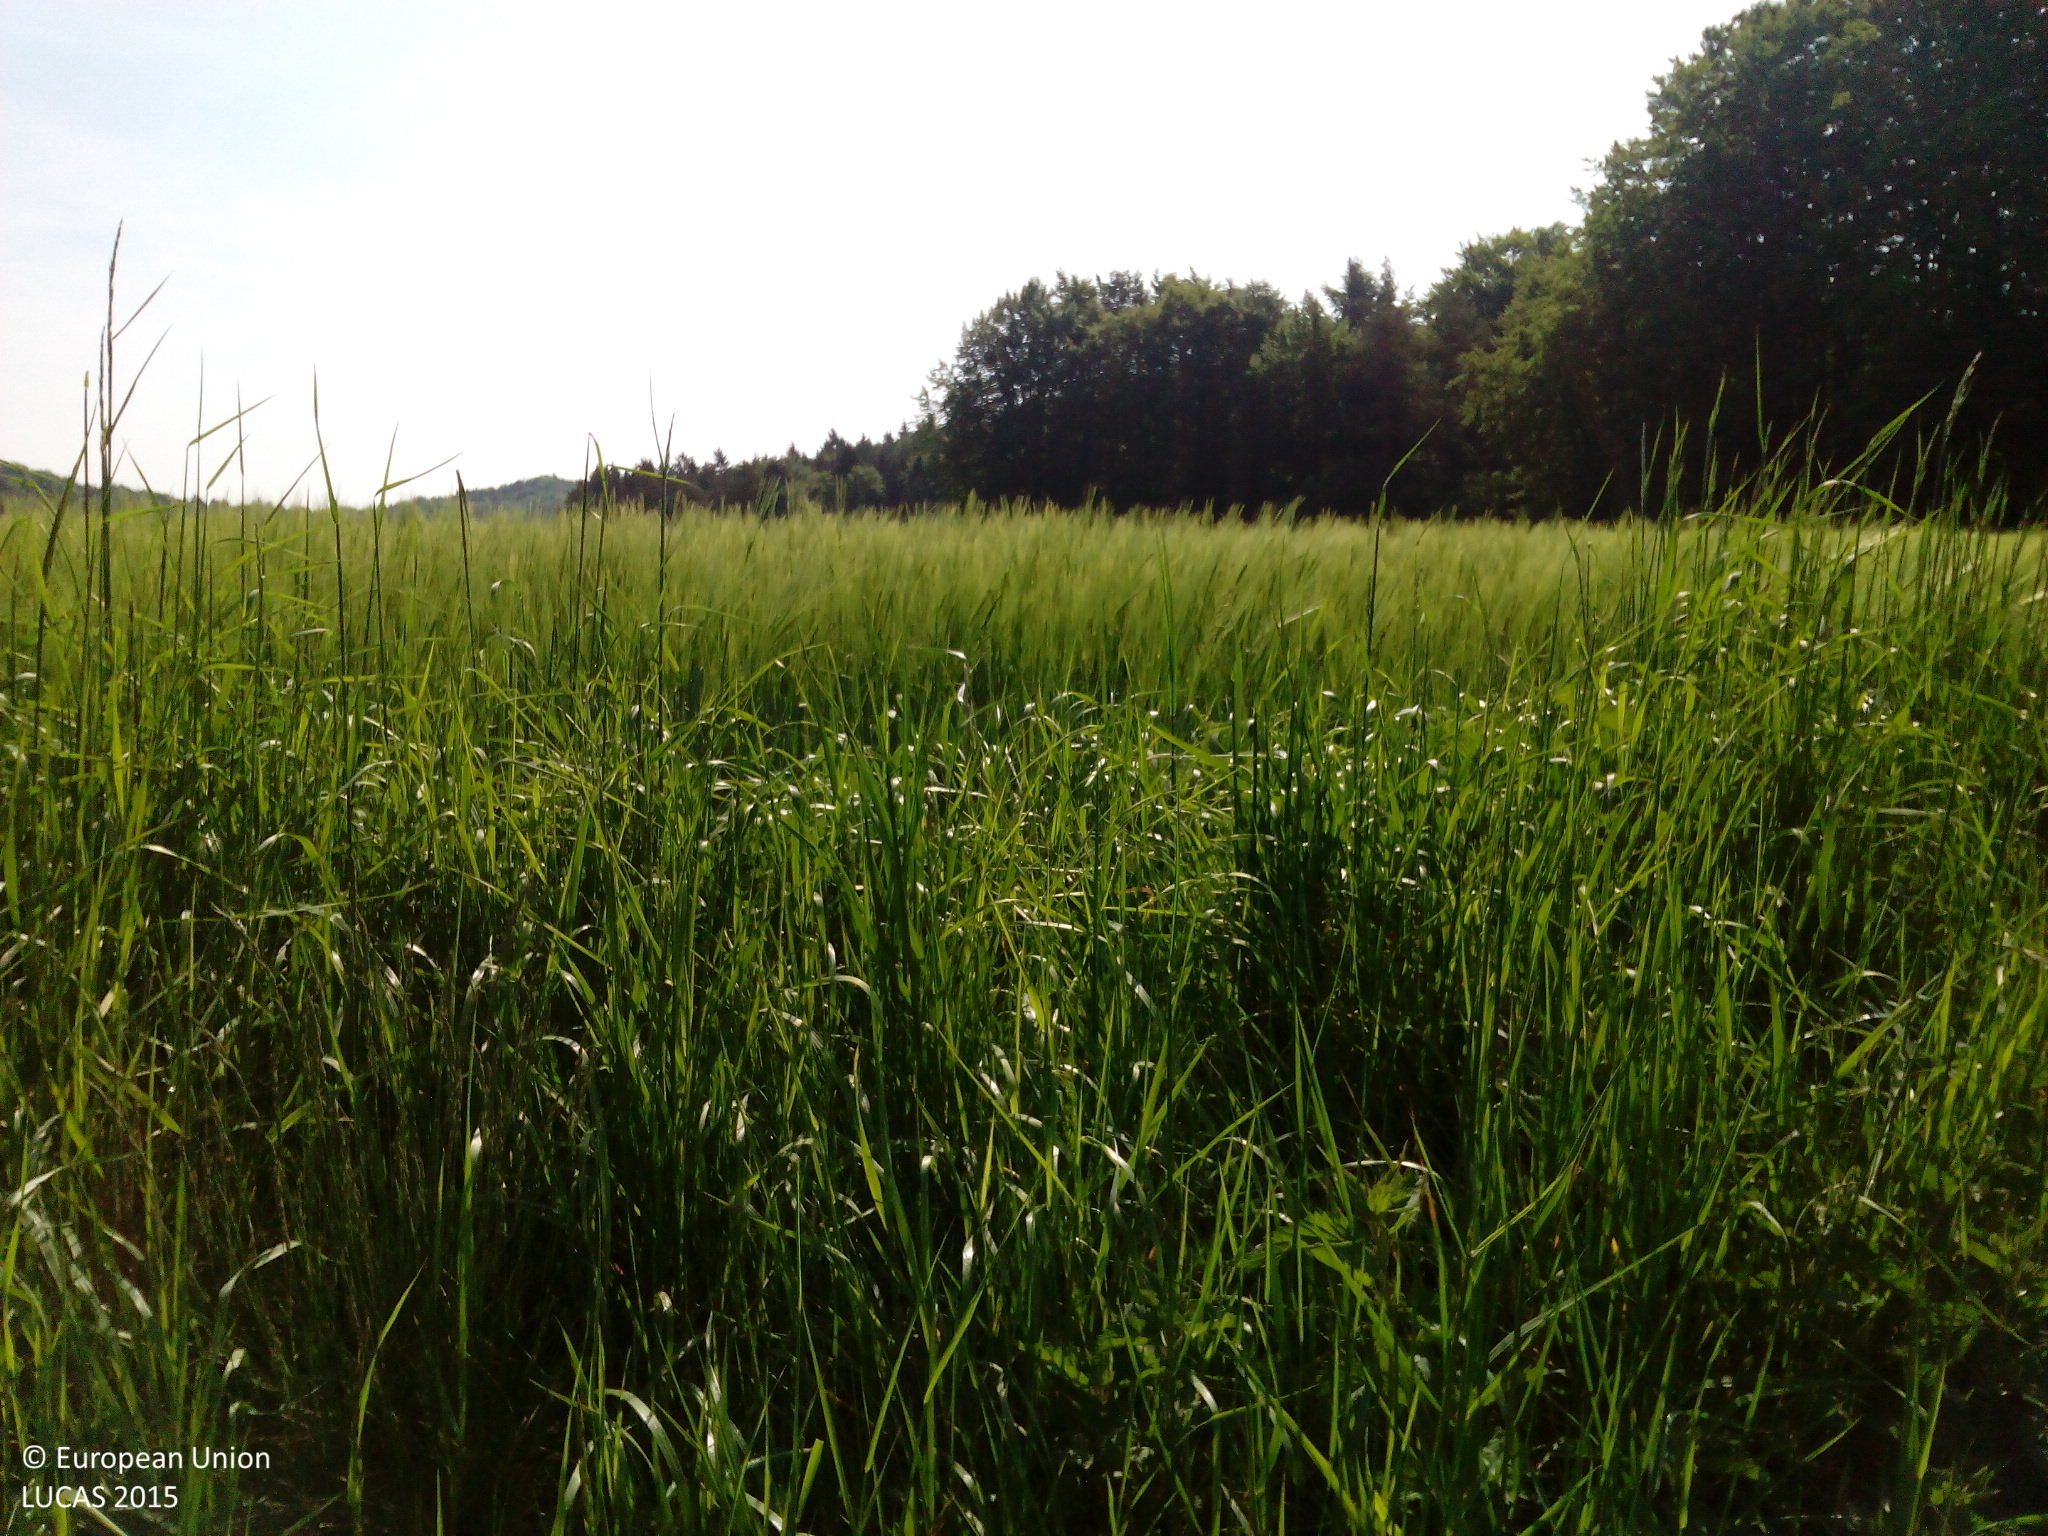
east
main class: Cropland
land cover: Triticale
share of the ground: > 75 %
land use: Agriculture (excluding fallow land and kitchen gardens)
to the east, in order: Triticale; Grass margins; Barley; Grassland without tree/shrub cover; Barley
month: May
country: DE
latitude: 49.4357
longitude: 11.5853
